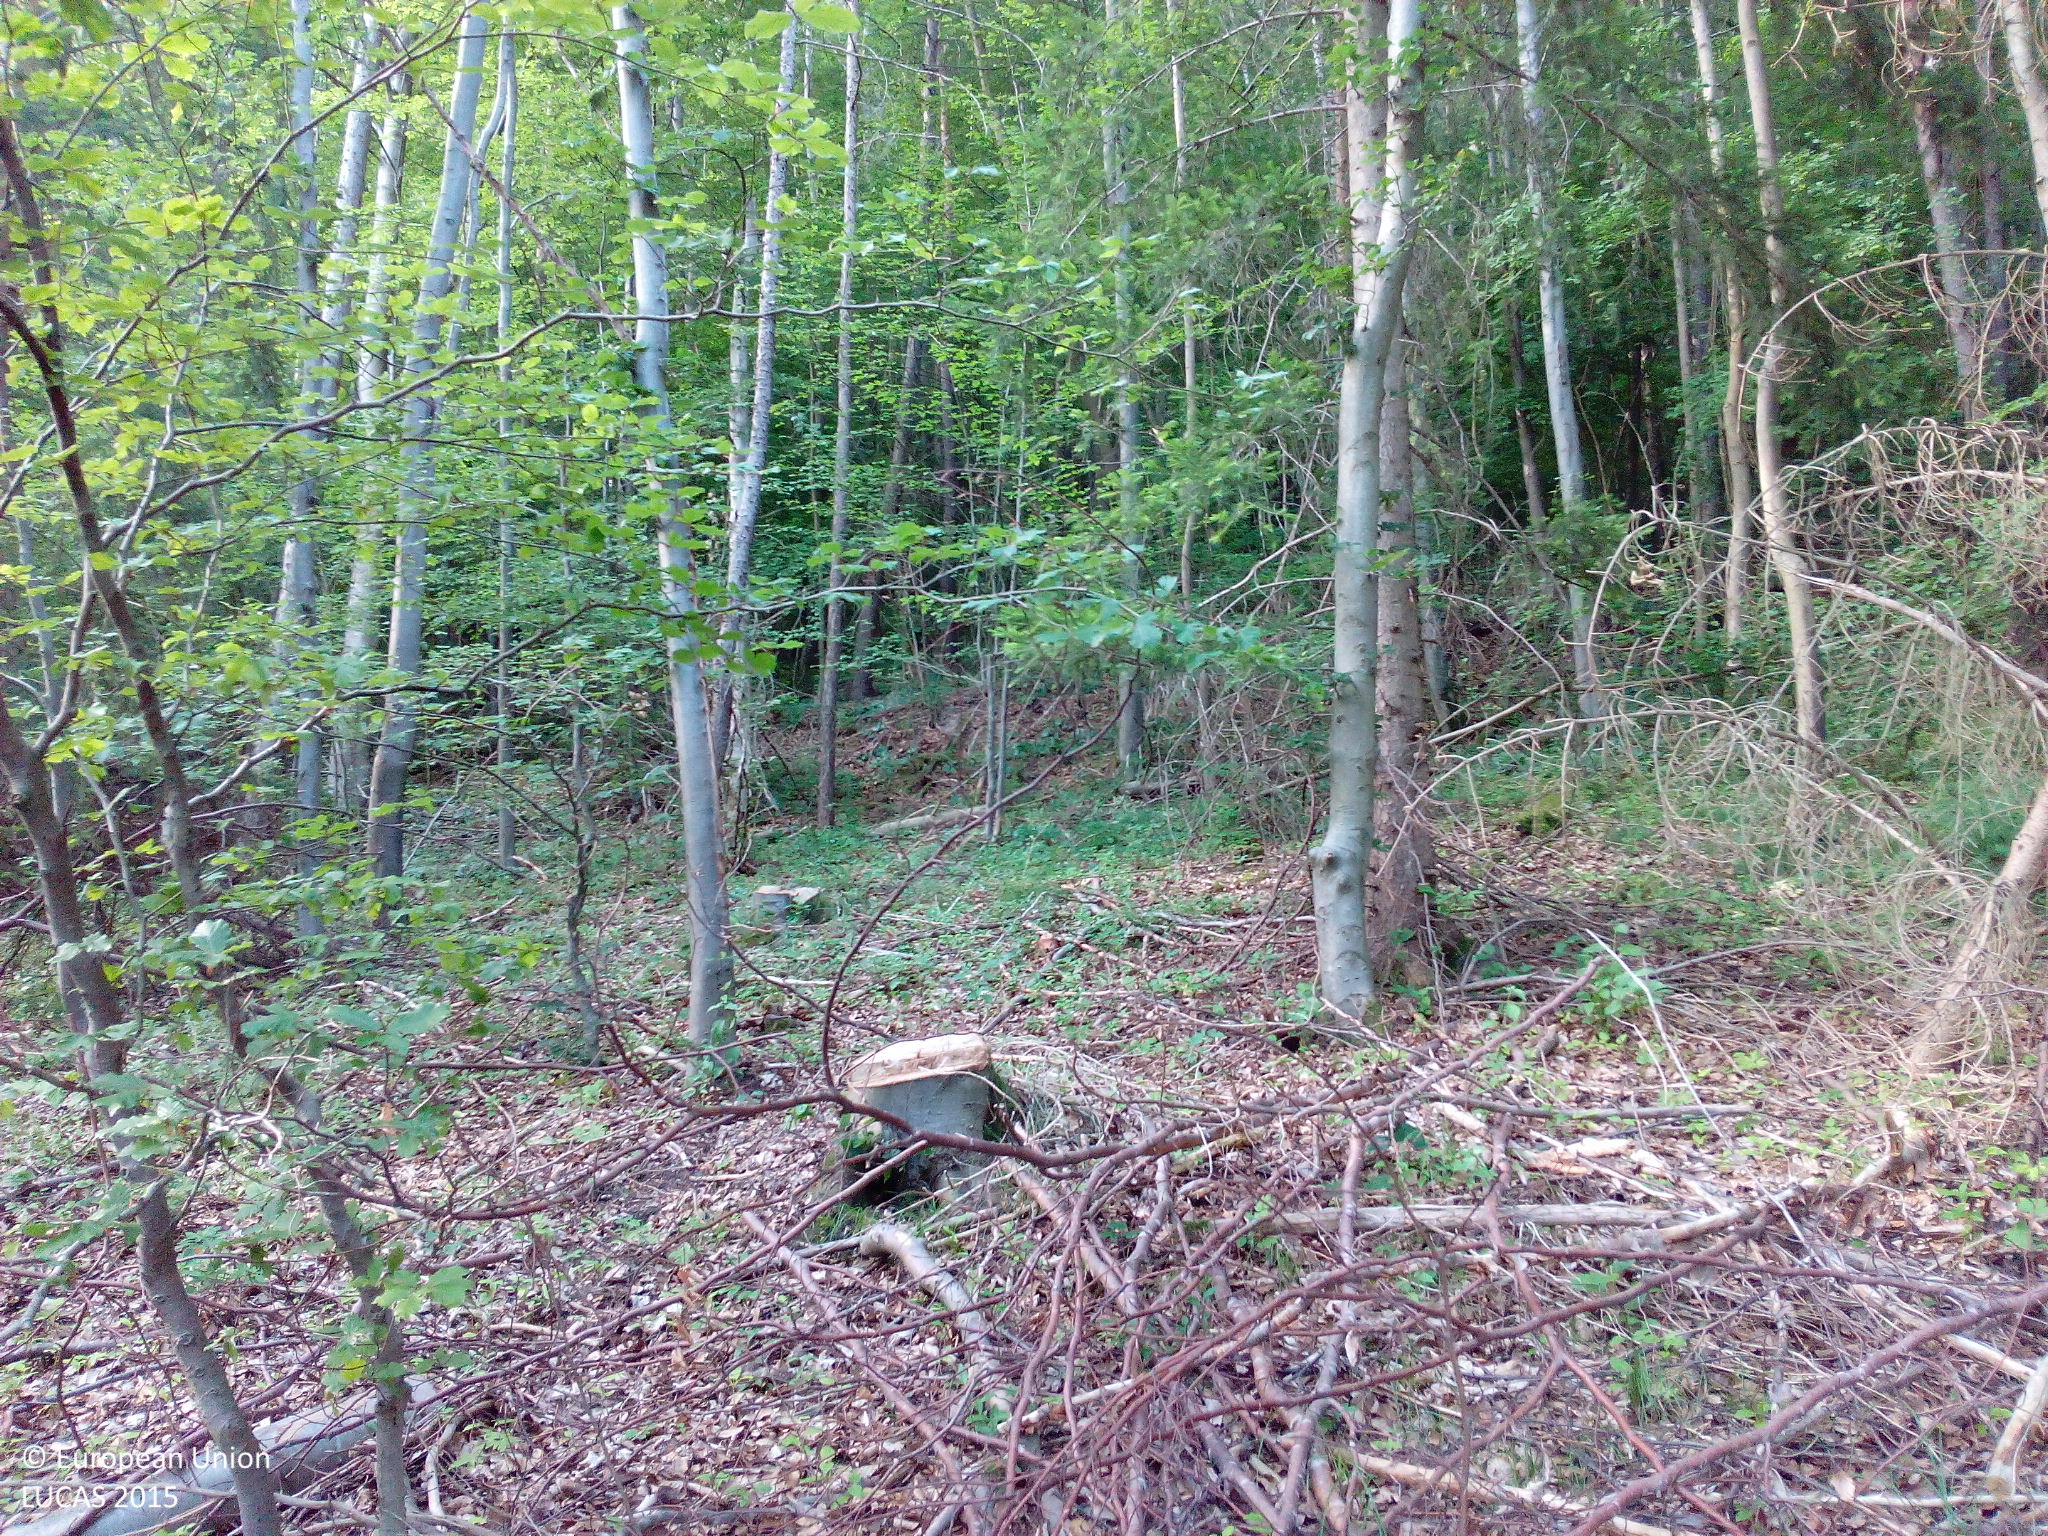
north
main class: Woodland
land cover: Spruce dominated mixed woodland
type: hemiboreal forest and nemoral coniferous forest and mixed broadleaved-coniferous forest
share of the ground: > 75 %
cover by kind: broadleaved forest trees 65 %, coniferous forest trees 25 %, unconsolidated bare surface 10 %
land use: Forestry
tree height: > 5 m
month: July
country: DE
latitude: 48.6010
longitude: 9.6883
